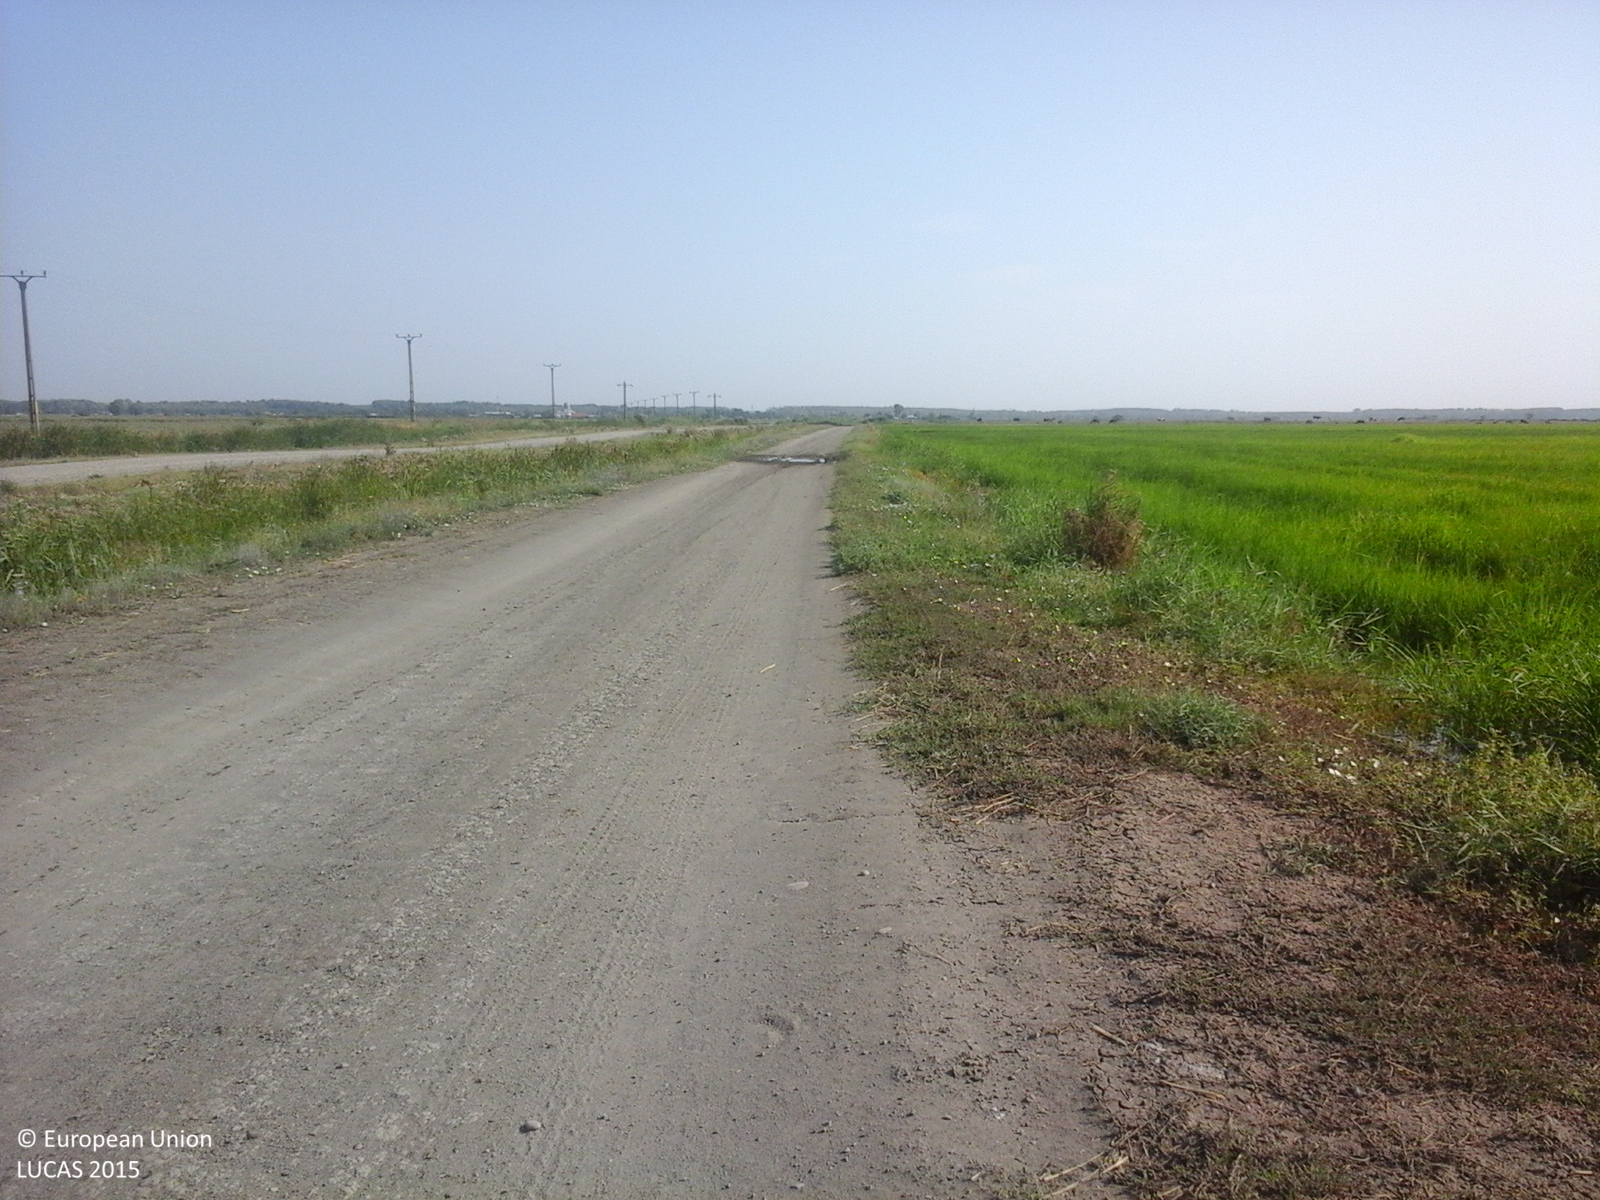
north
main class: Cropland
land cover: Rice
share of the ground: > 75 %
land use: Agriculture (excluding fallow land and kitchen gardens)
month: August
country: RO
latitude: 45.3733
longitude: 27.8216
